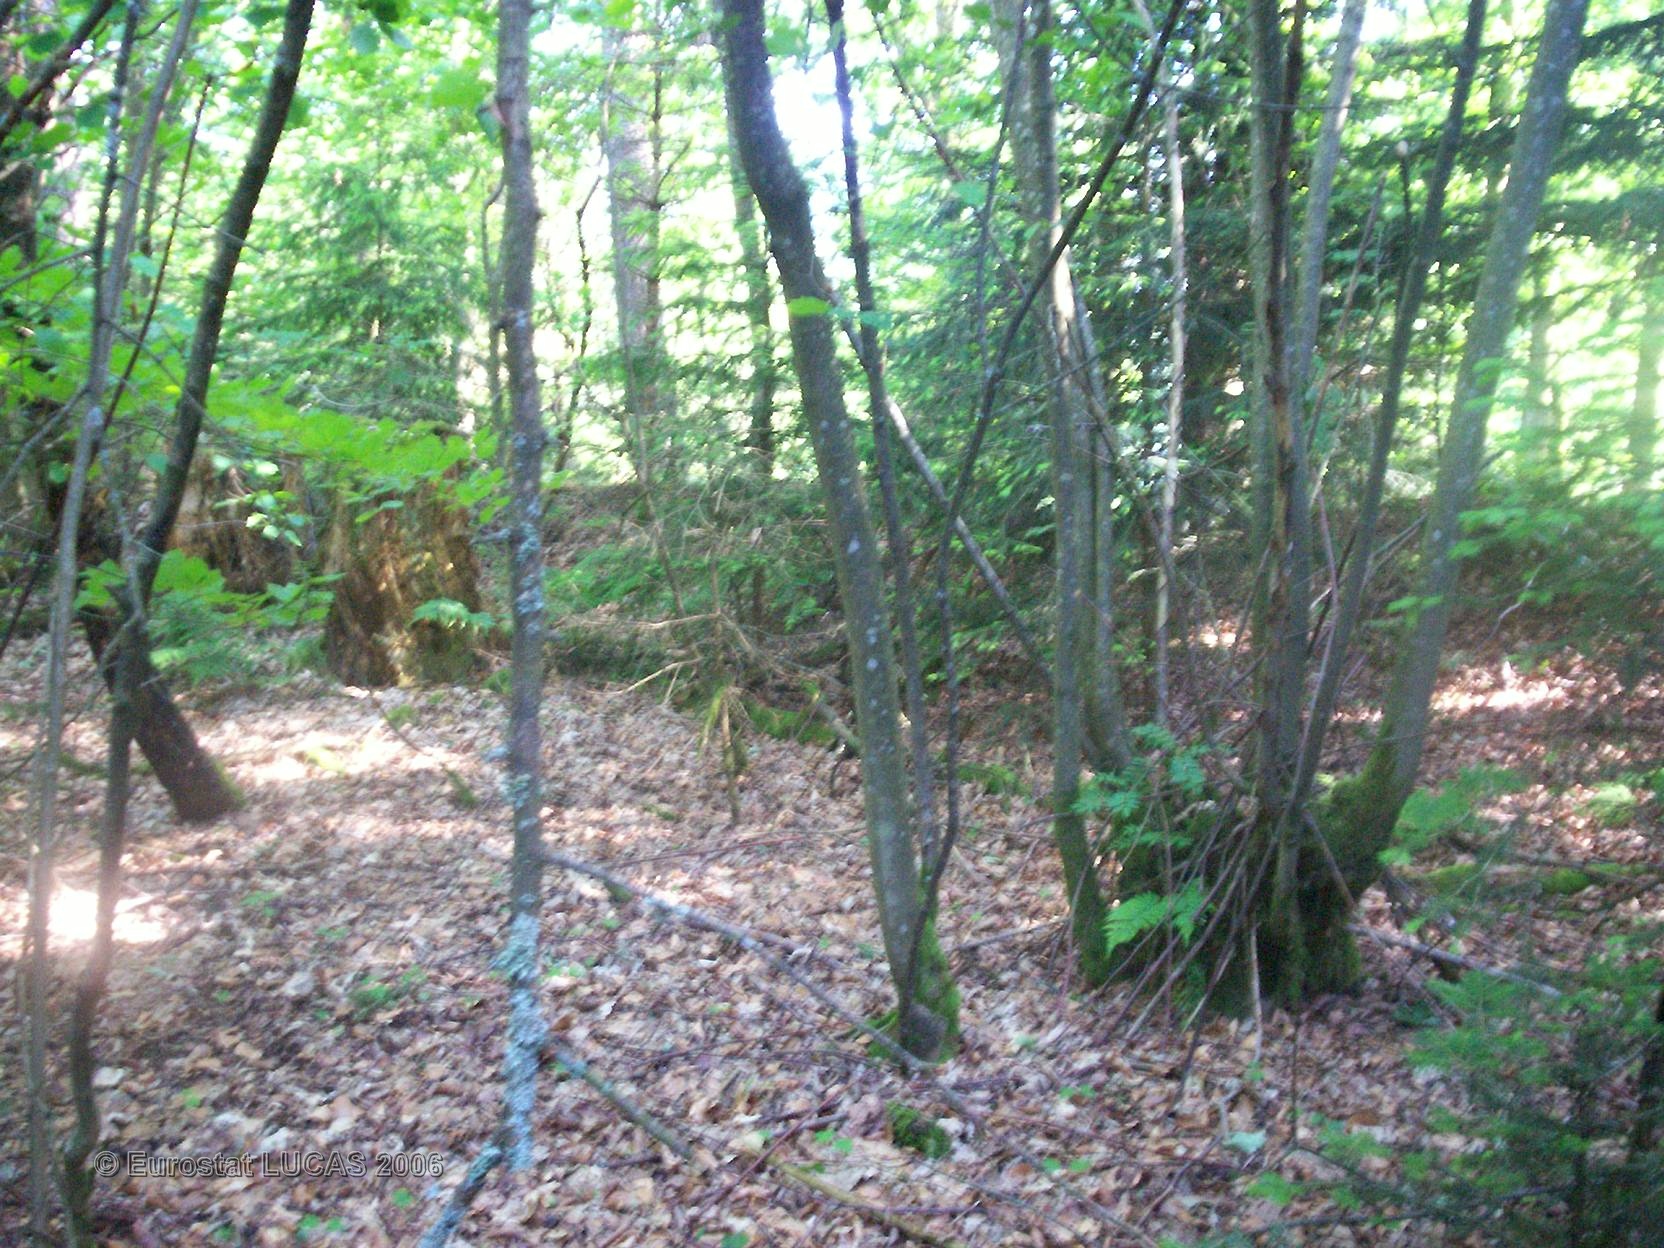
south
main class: Woodland
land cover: Coniferous forest
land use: Forestry
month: June
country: FR
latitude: 48.3274
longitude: 7.0200
